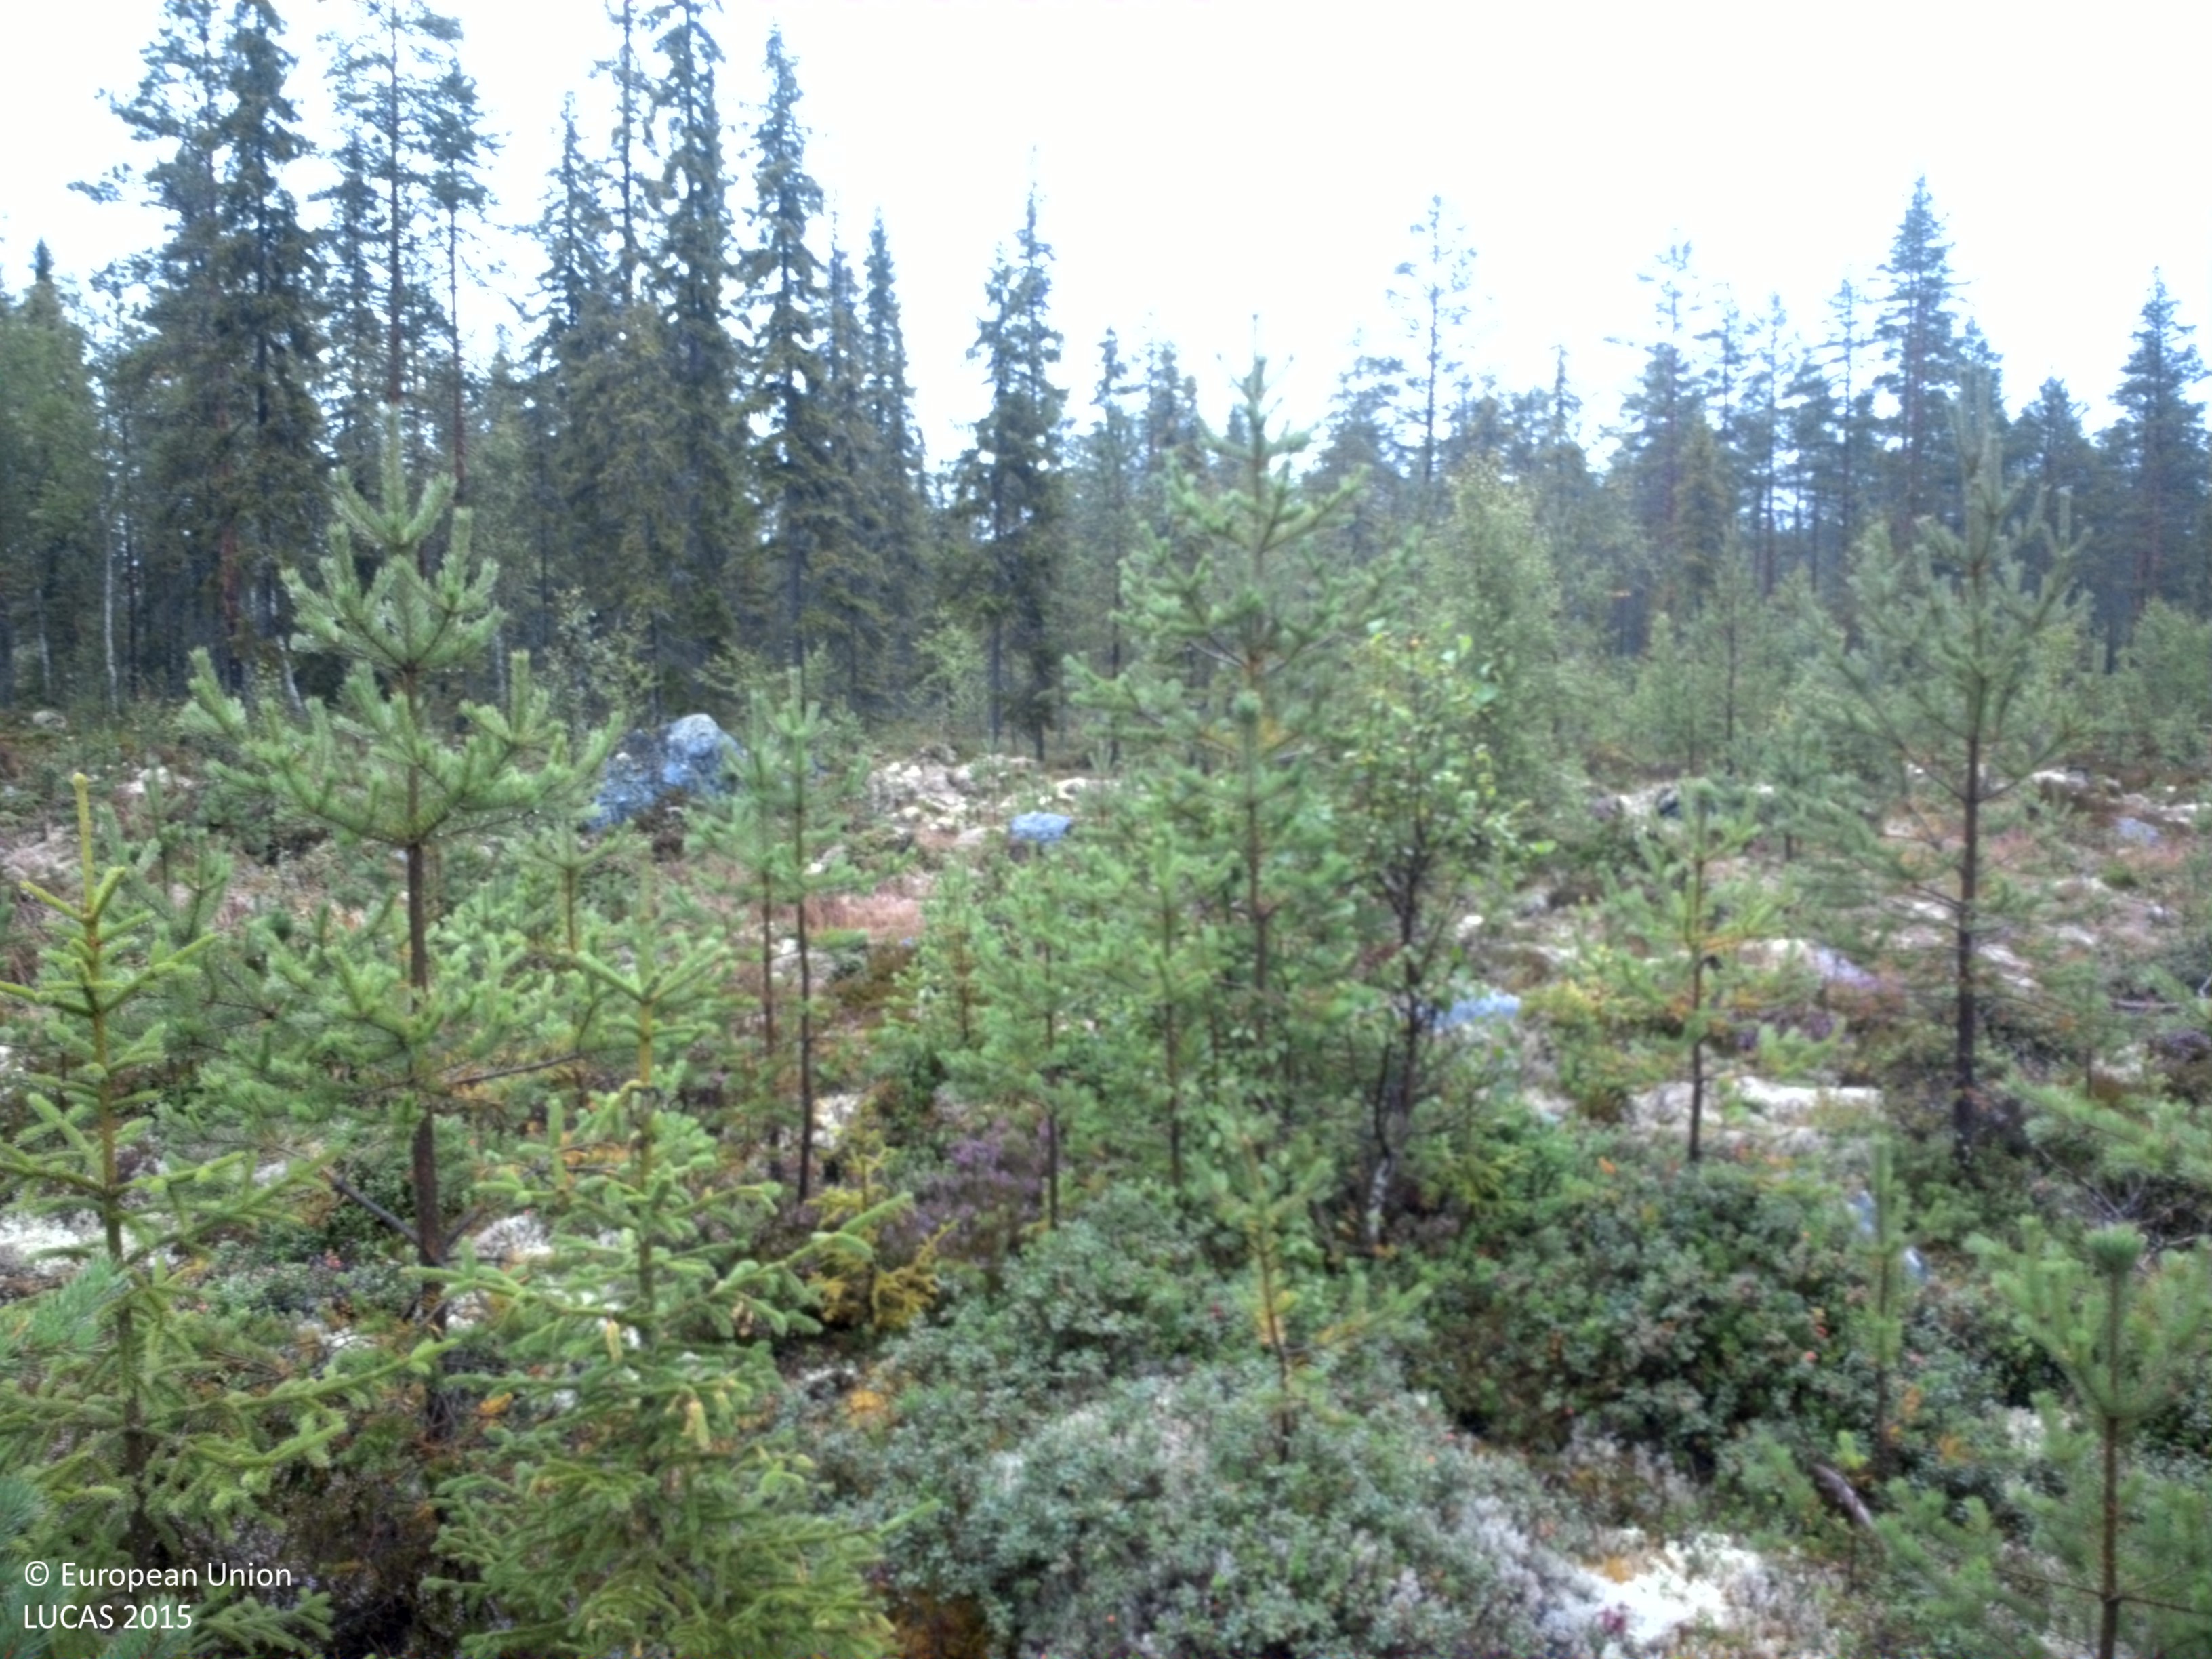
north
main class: Woodland
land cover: Pine dominated coniferous woodland
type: boreal forest
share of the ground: 10 - 25 %
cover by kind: shrubs 65 %, lichens and mosses 20 %, coniferous forest trees 15 %
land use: Forestry
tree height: < 5 m
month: August
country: SE
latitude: 61.7333
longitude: 15.0374
